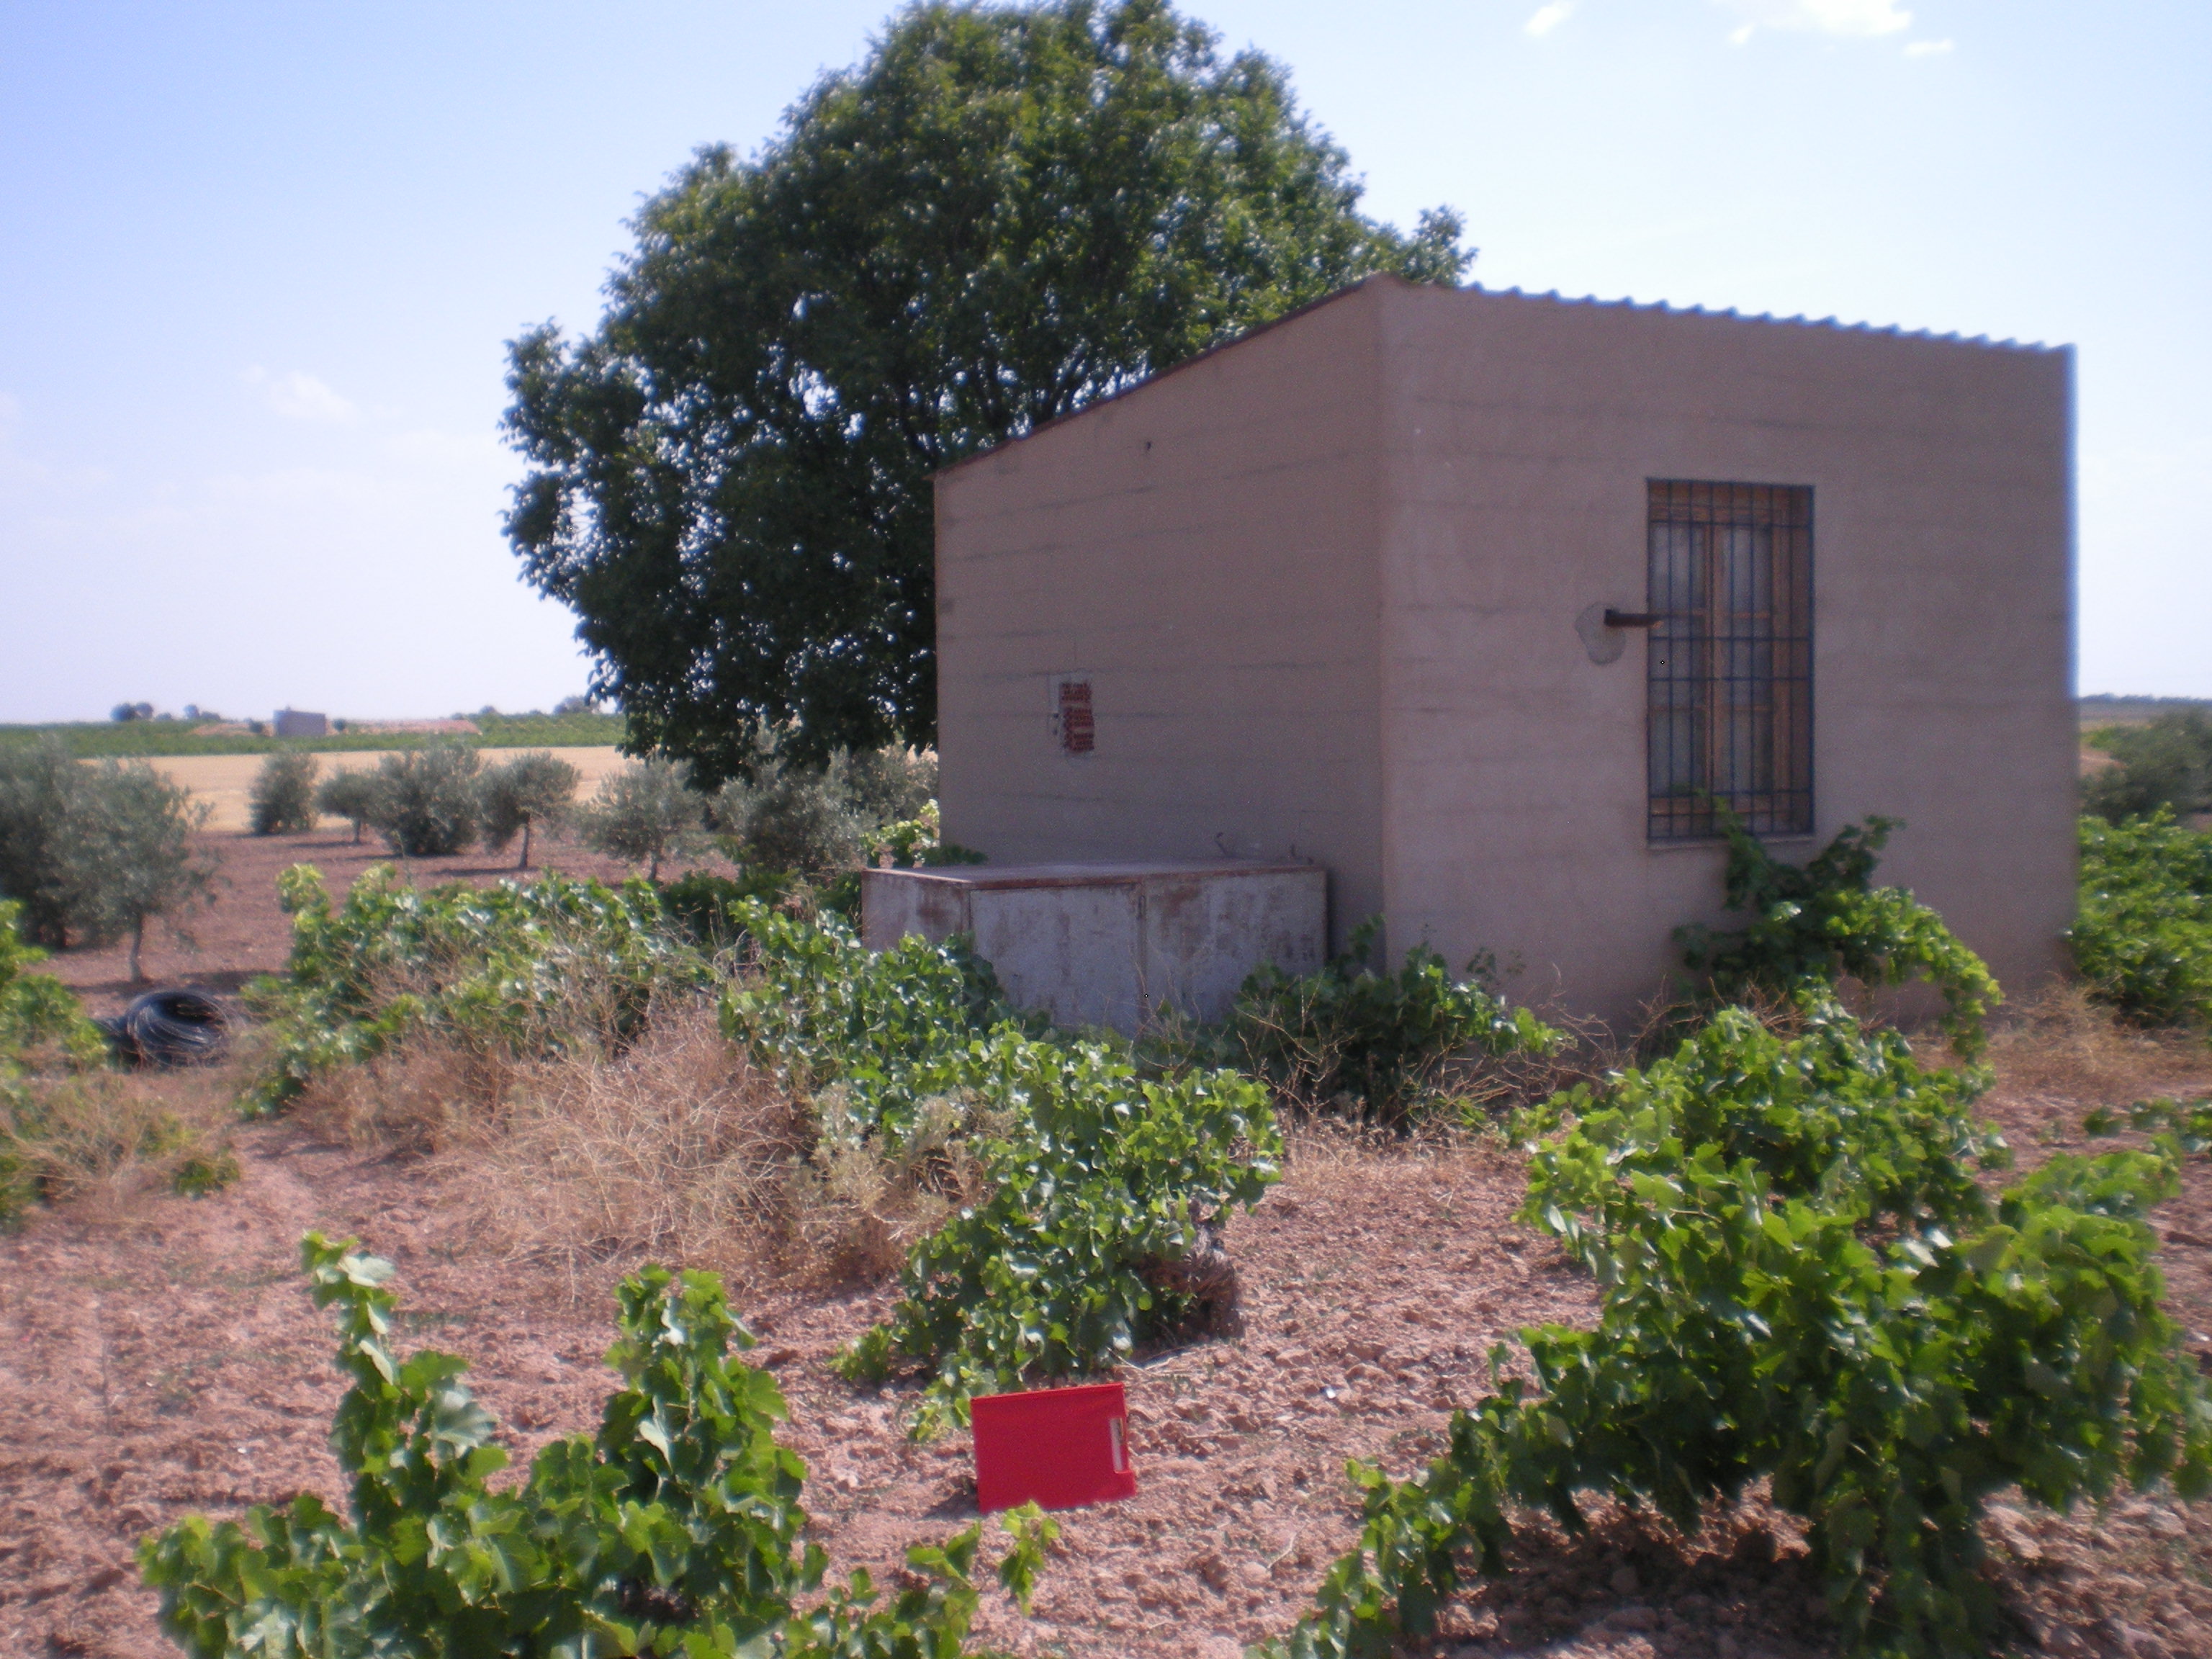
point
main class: Cropland
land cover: Vineyards
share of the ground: 25 - 50 %
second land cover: Other bare soil
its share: > 75 %
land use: Agriculture (excluding fallow land and kitchen gardens)
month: July
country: ES
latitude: 39.3513
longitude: -3.2114
